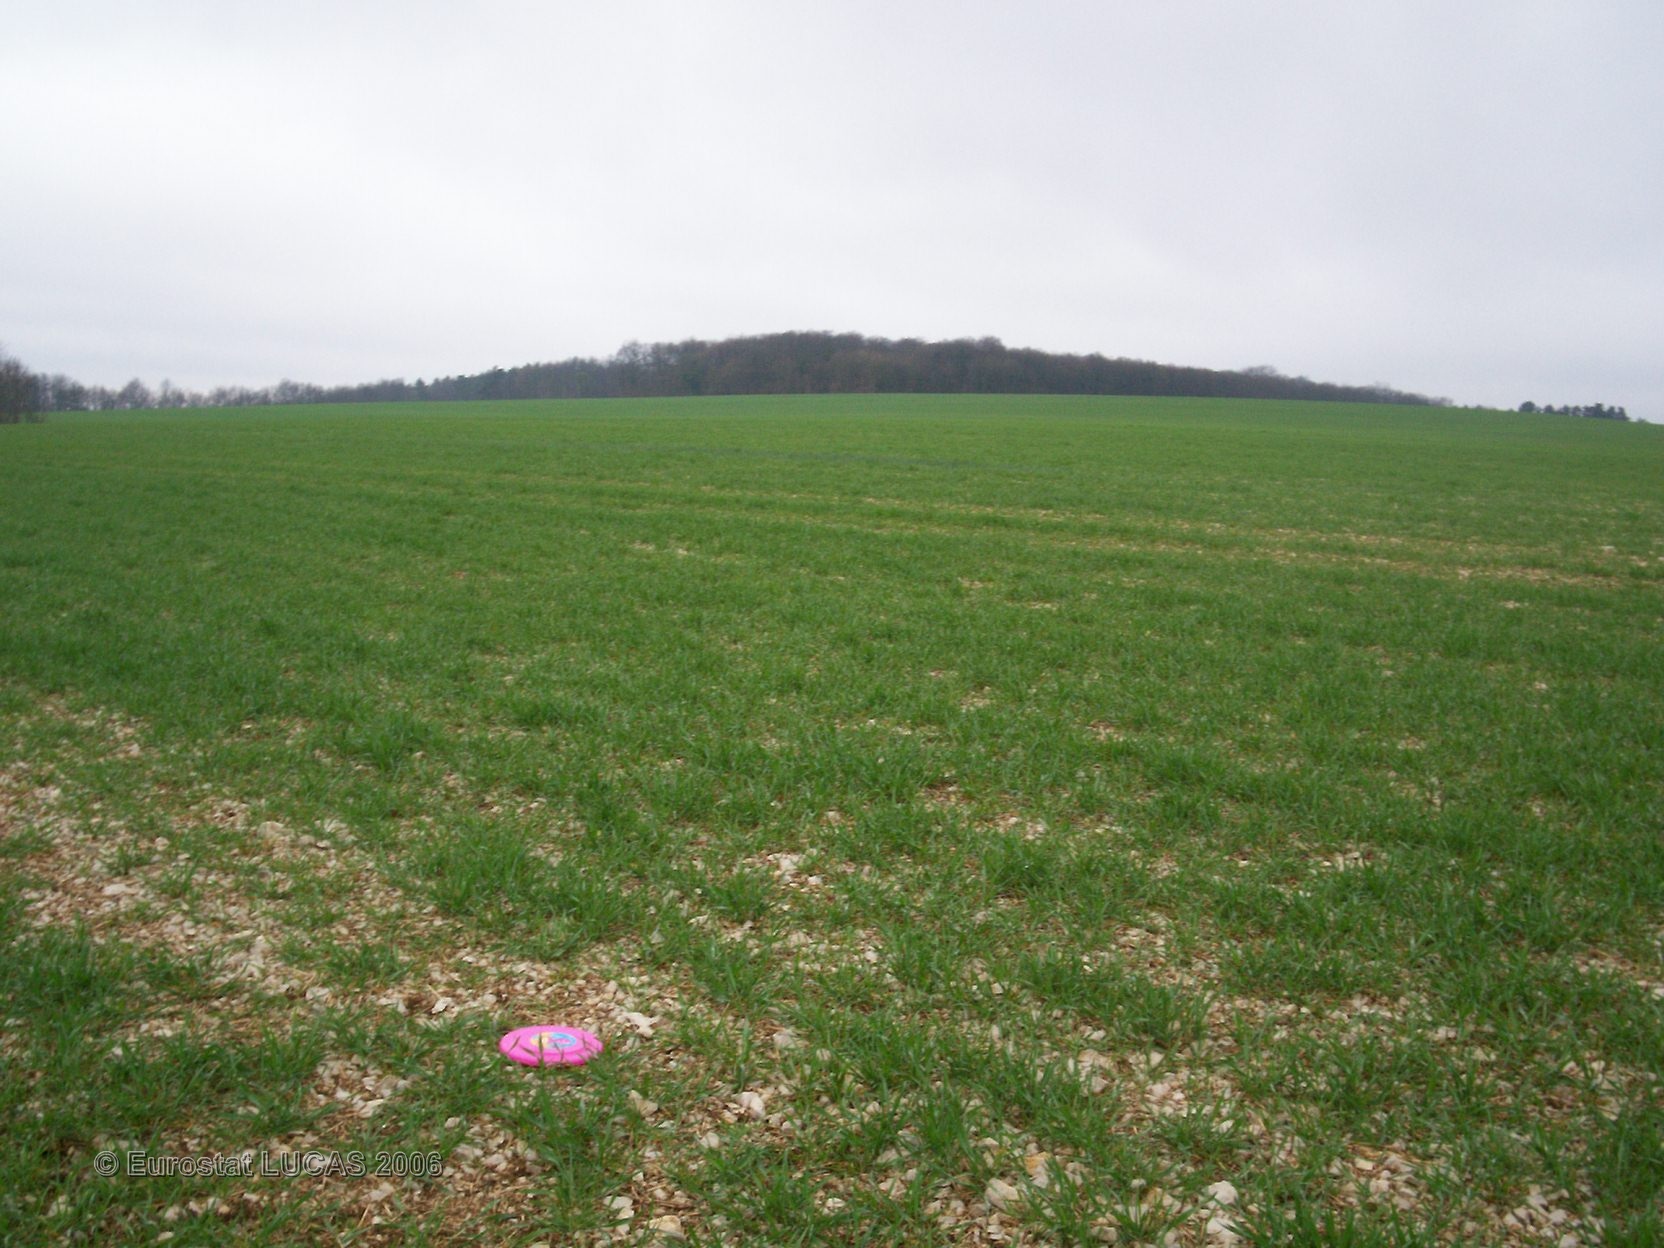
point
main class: Cropland
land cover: Common wheat
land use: Agriculture (excluding fallow land and kitchen gardens)
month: April
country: FR
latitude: 48.1032
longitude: 4.4784
